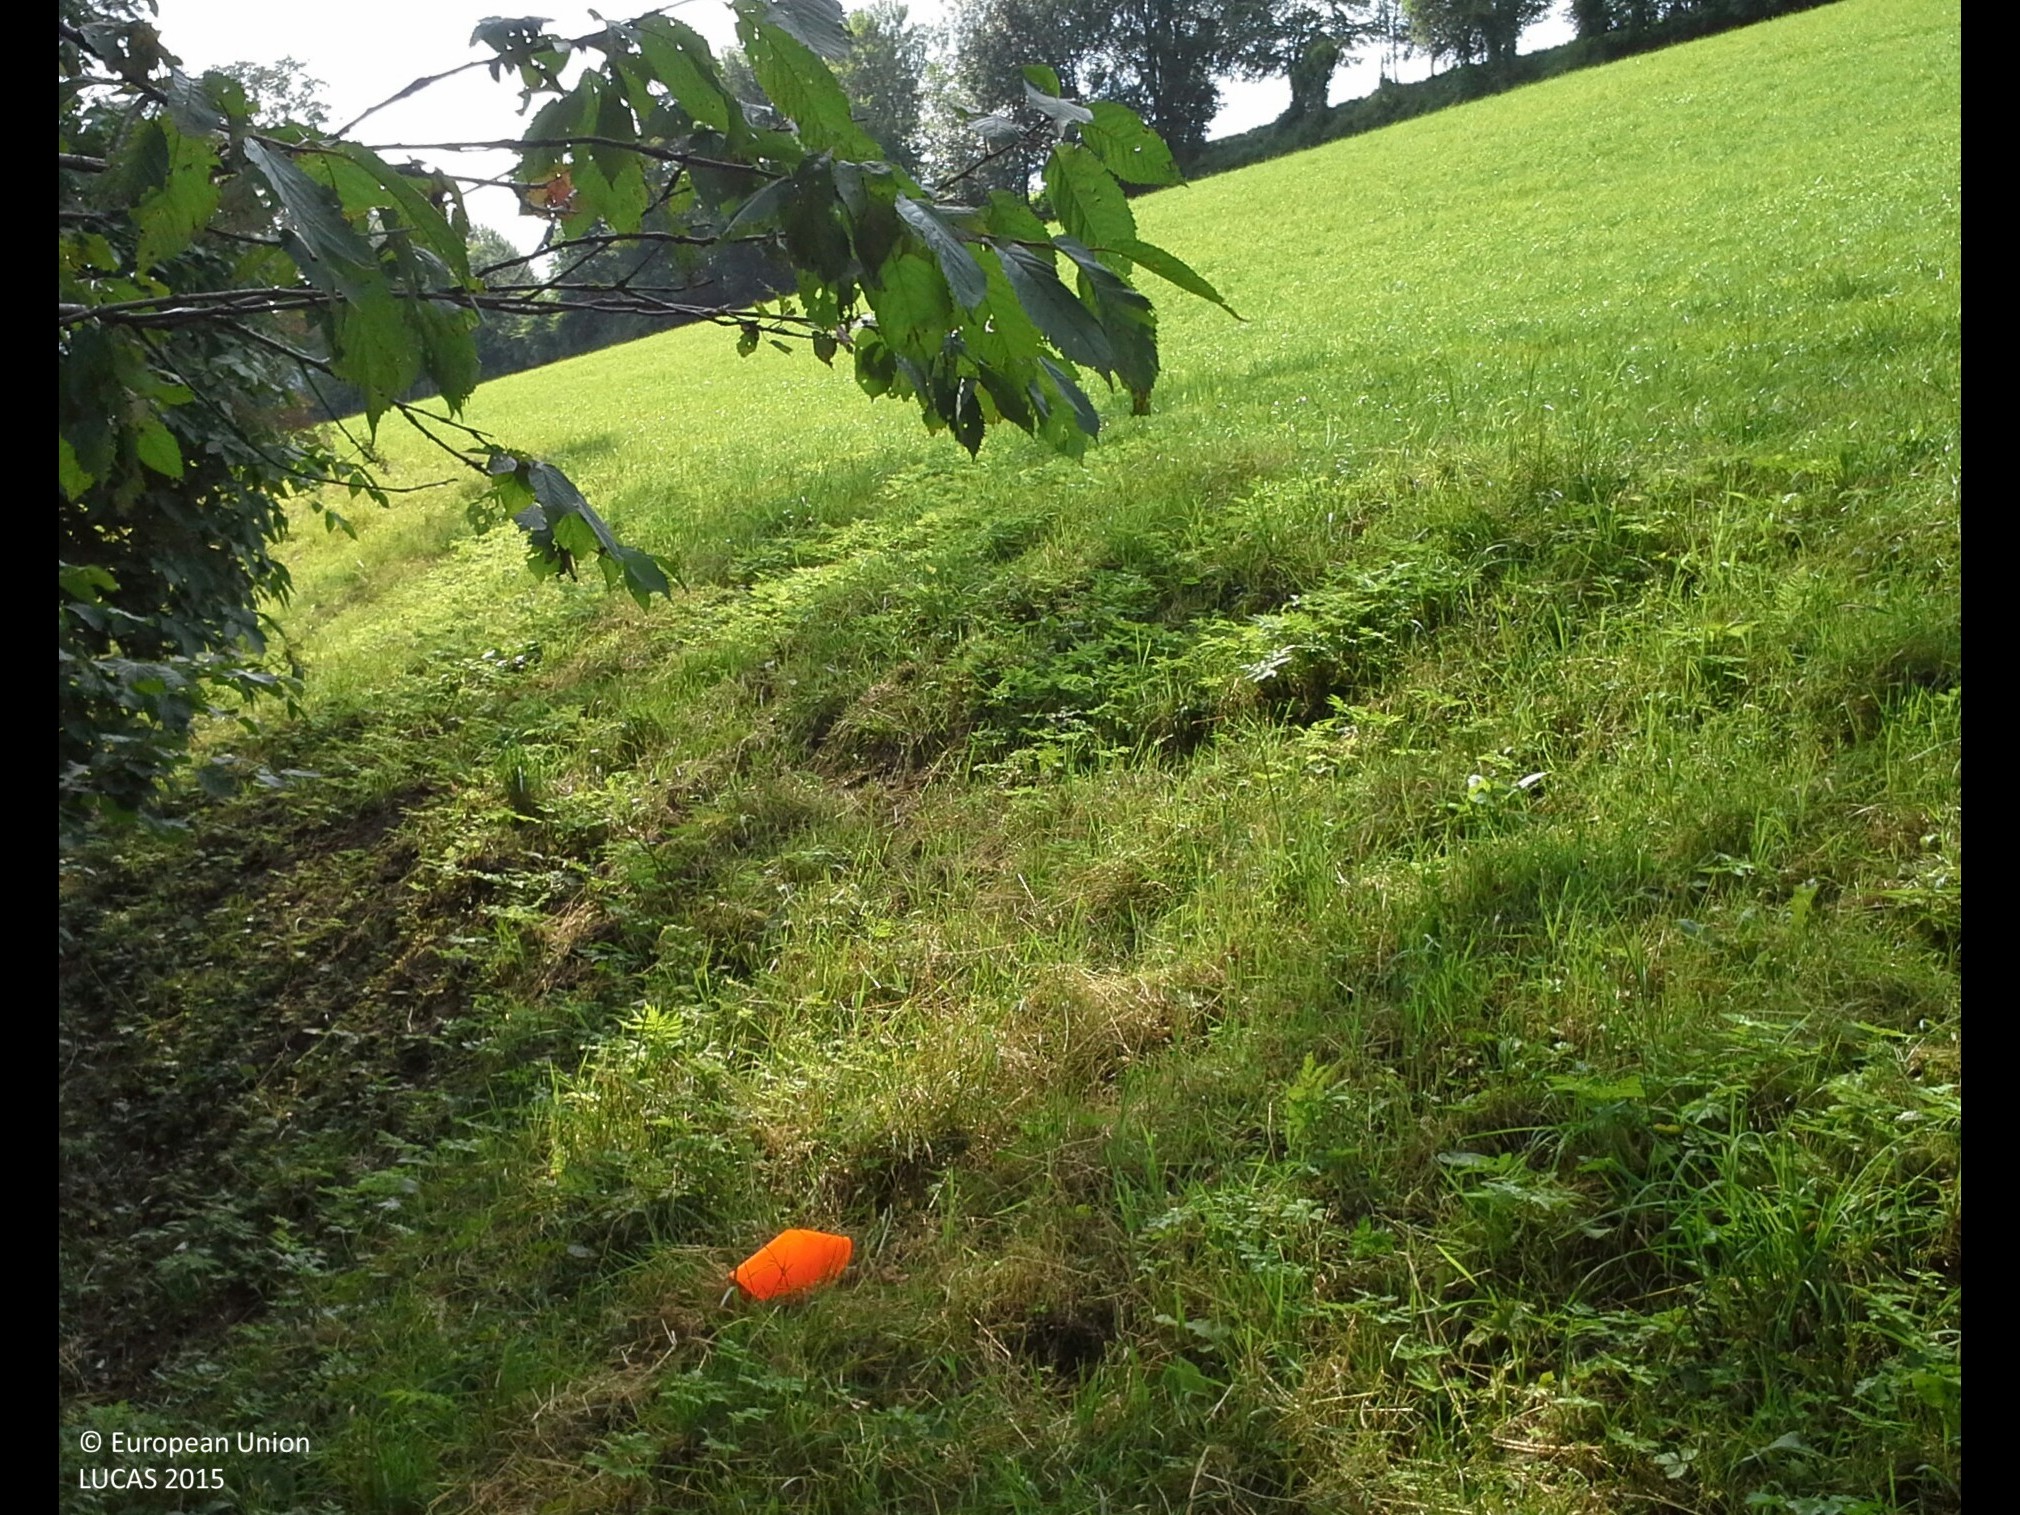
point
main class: Grassland
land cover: Grassland without tree/shrub cover
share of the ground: > 75 %
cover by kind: herbaceous plants 90 %, lichens and mosses 10 %
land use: Agriculture (excluding fallow land and kitchen gardens)
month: July
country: AT
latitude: 47.9477
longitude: 14.5925
